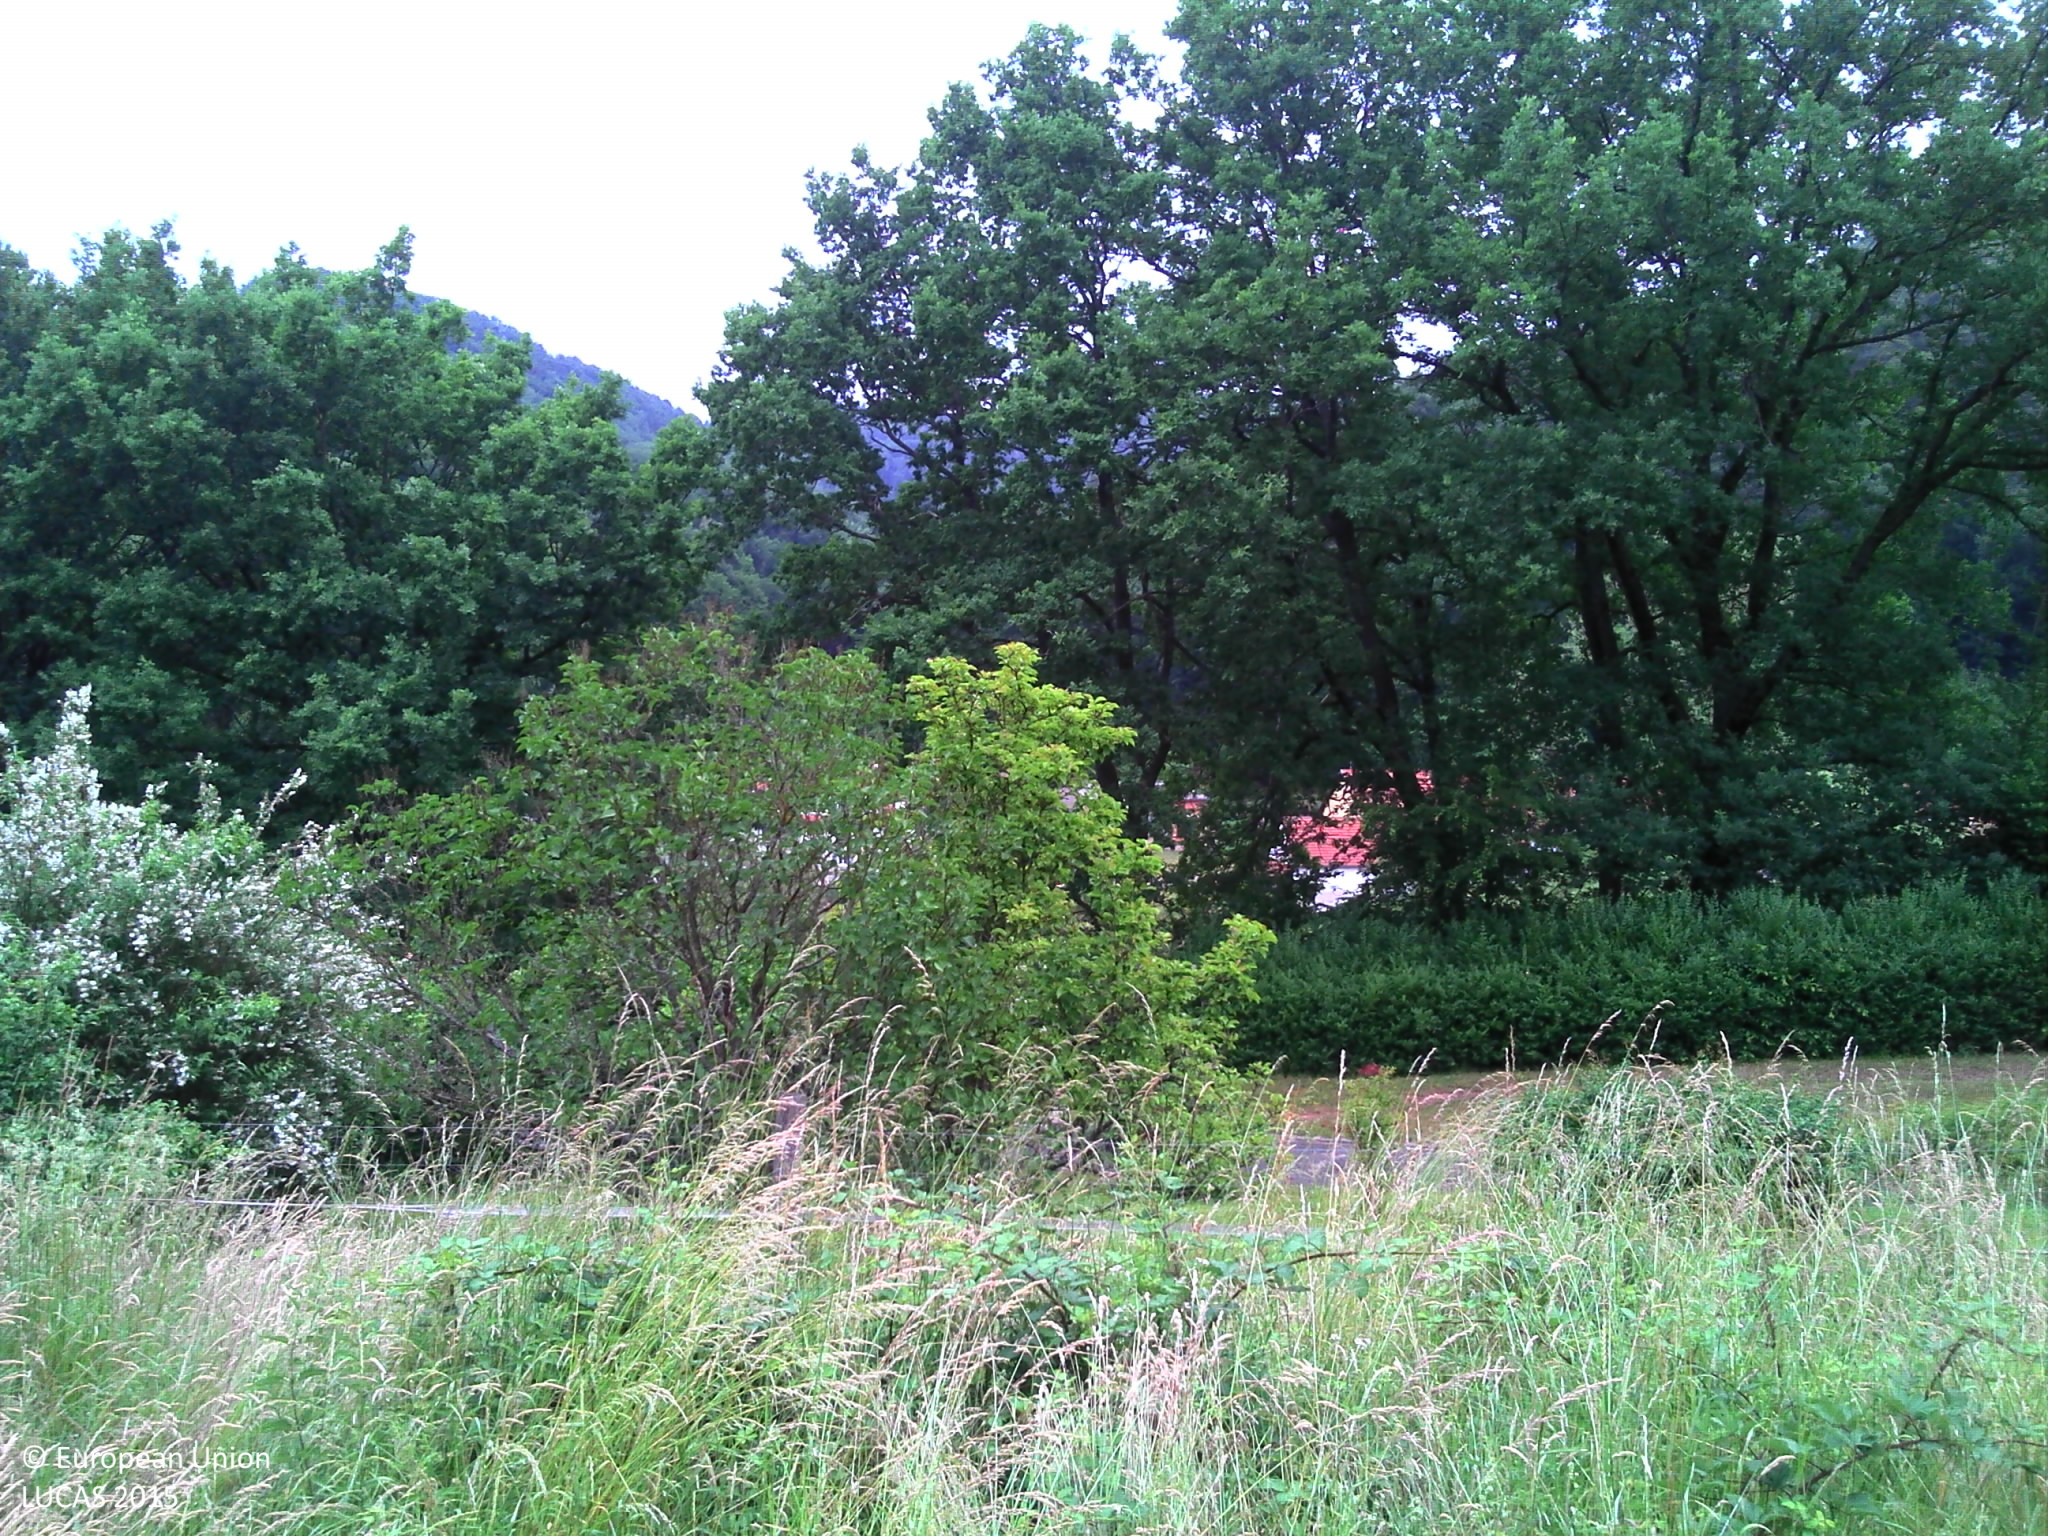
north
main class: Grassland
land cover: Grassland without tree/shrub cover
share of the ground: > 75 %
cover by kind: herbaceous plants 100 %
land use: Agriculture (excluding fallow land and kitchen gardens)
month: June
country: FR
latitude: 49.0279
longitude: 7.7166
